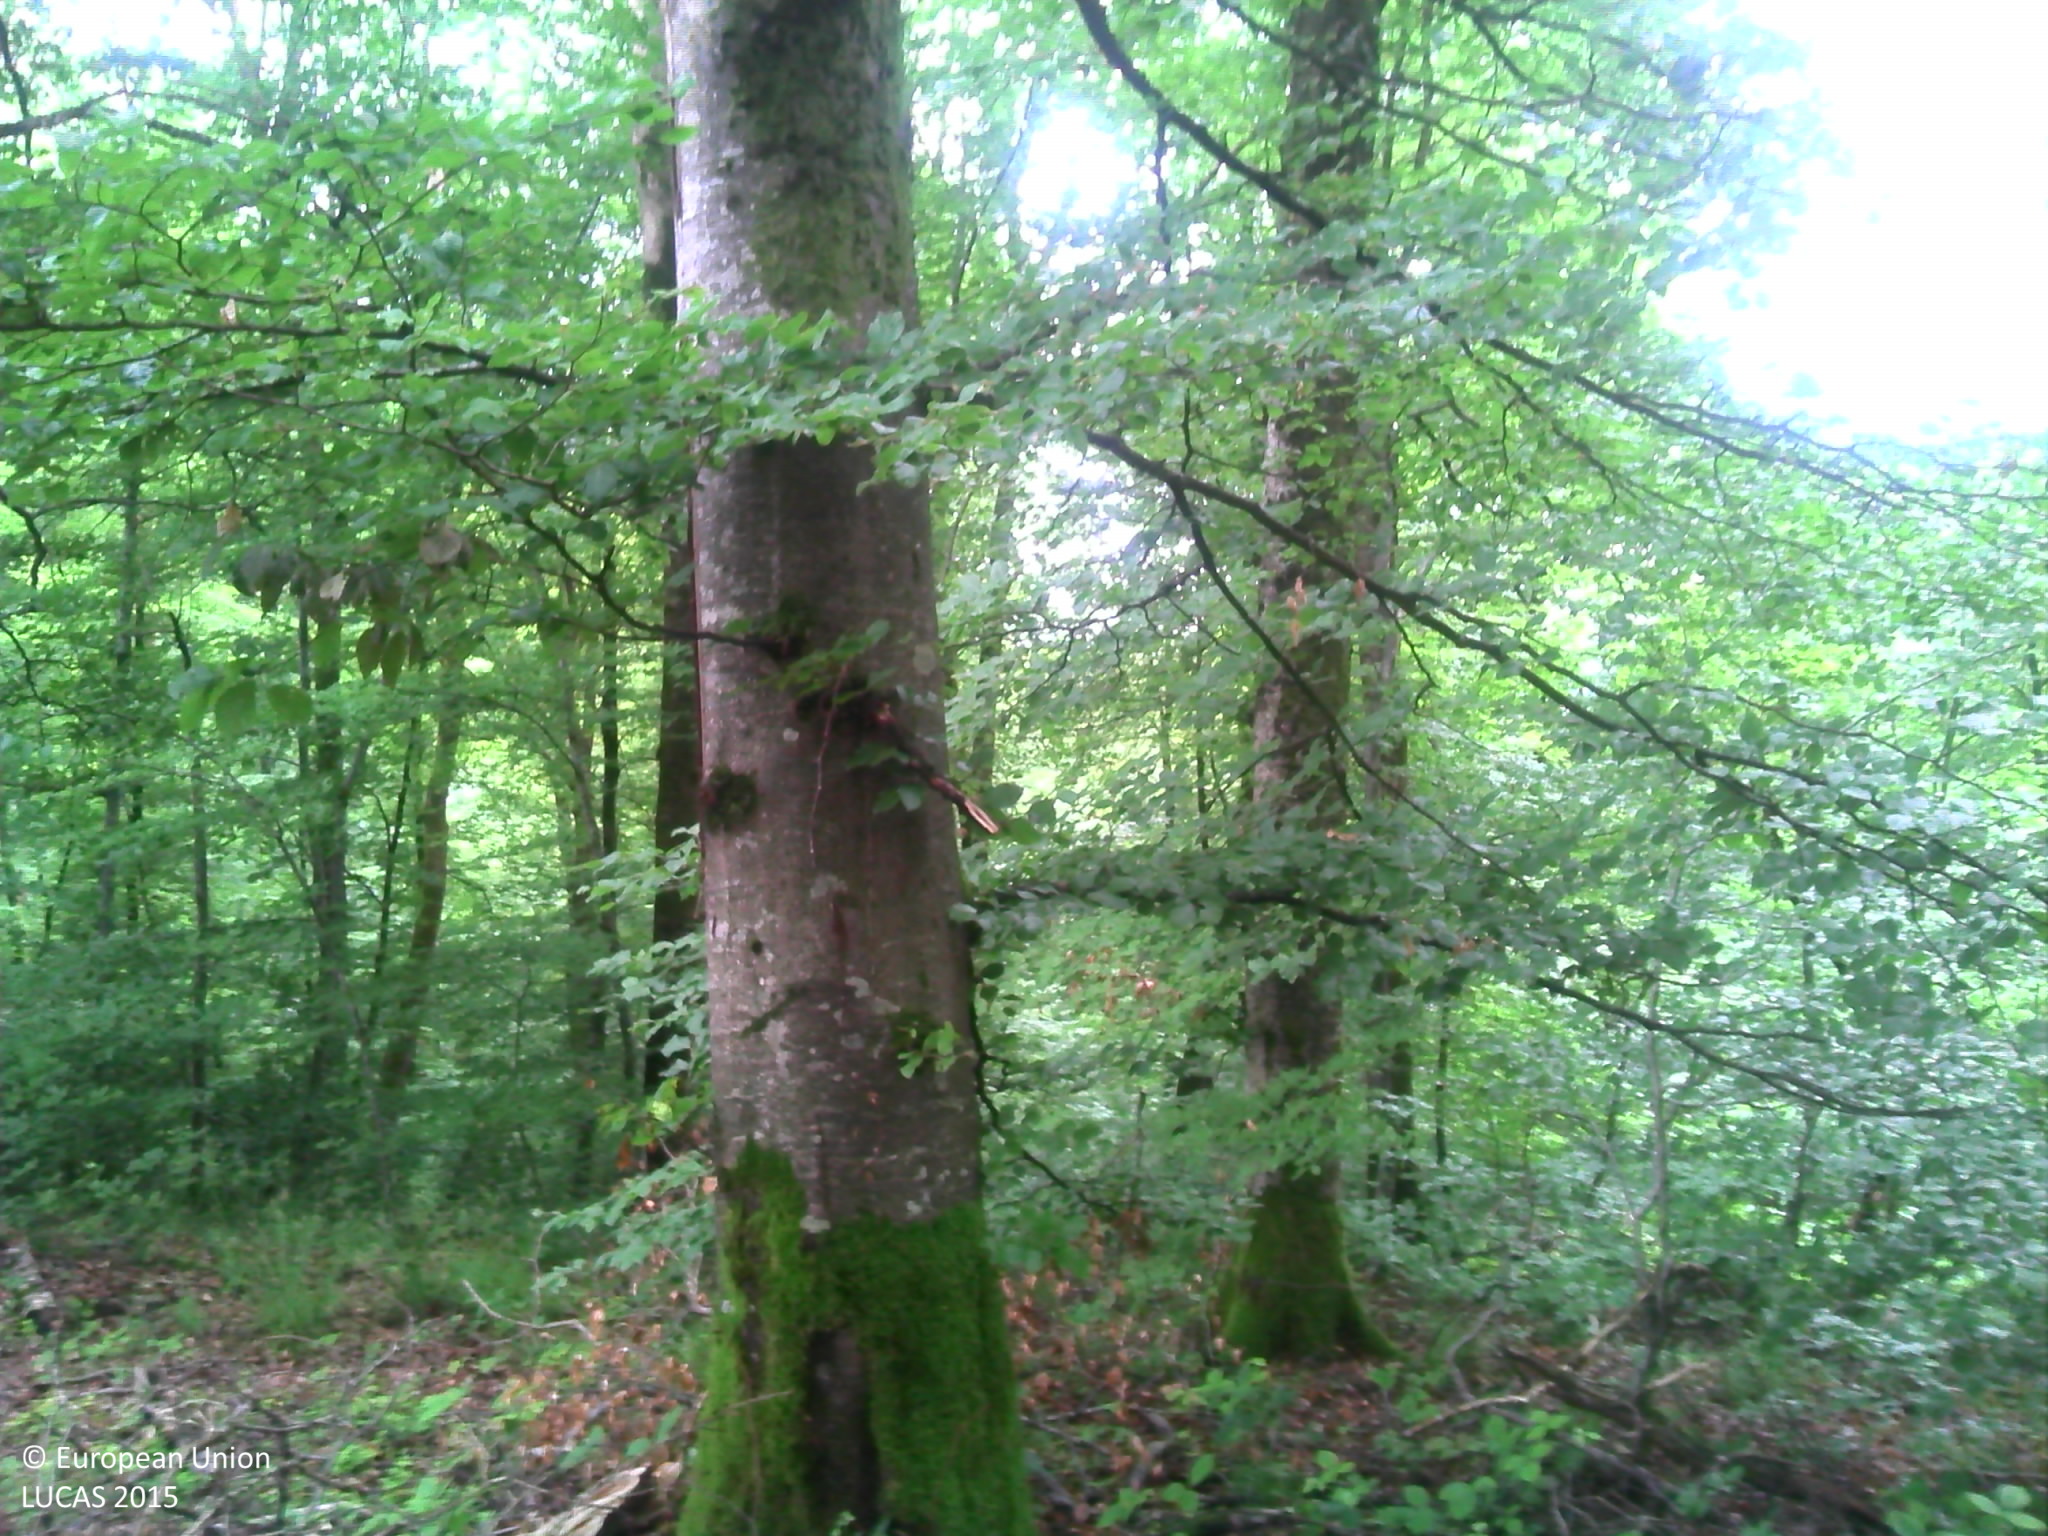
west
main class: Woodland
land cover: Broadleaved woodland
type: beech forest
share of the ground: > 75 %
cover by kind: broadleaved forest trees 90 %, shrubs 5 %, herbaceous plants 5 %
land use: Forestry
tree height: > 5 m
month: June
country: FR
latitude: 47.6772
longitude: 6.3650
